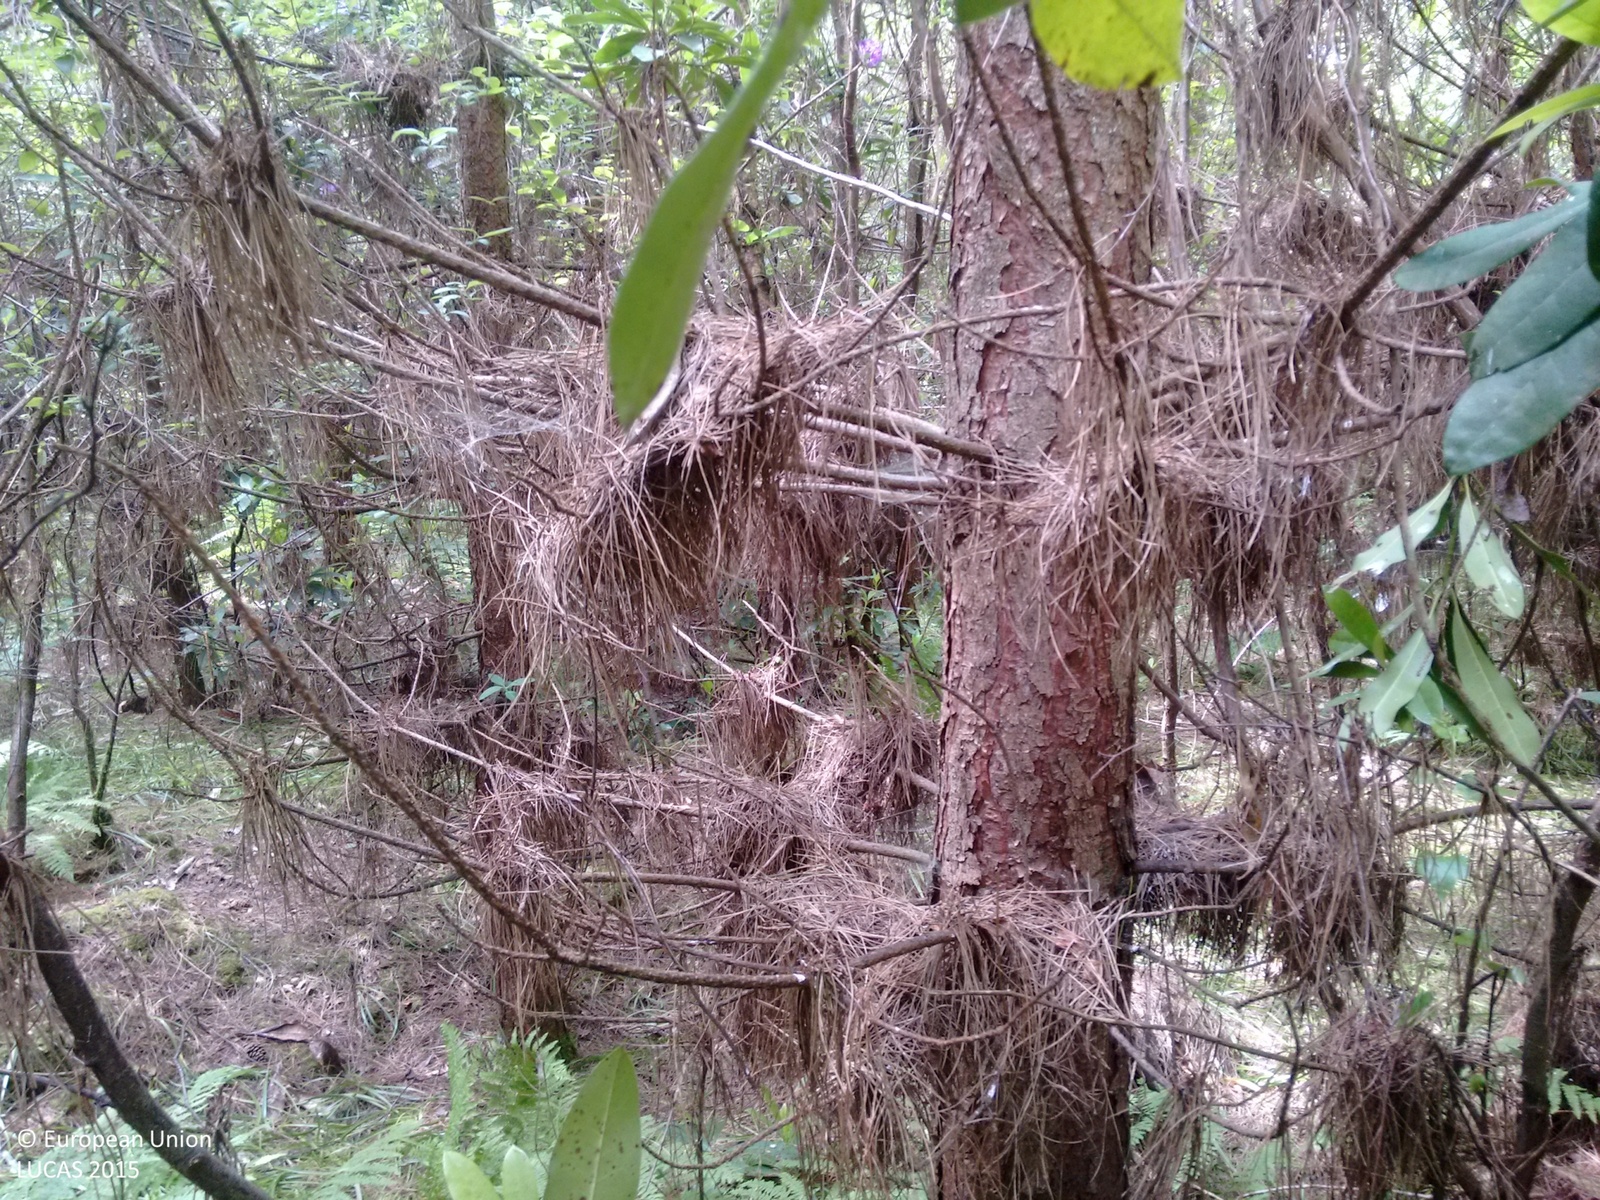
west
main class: Woodland
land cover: Pine dominated coniferous woodland
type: exotic forest
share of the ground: > 75 %
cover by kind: coniferous forest trees 95 %, shrubs 5 %
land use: Forestry
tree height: > 5 m
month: June
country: GB
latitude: 51.0979
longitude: 0.5911
